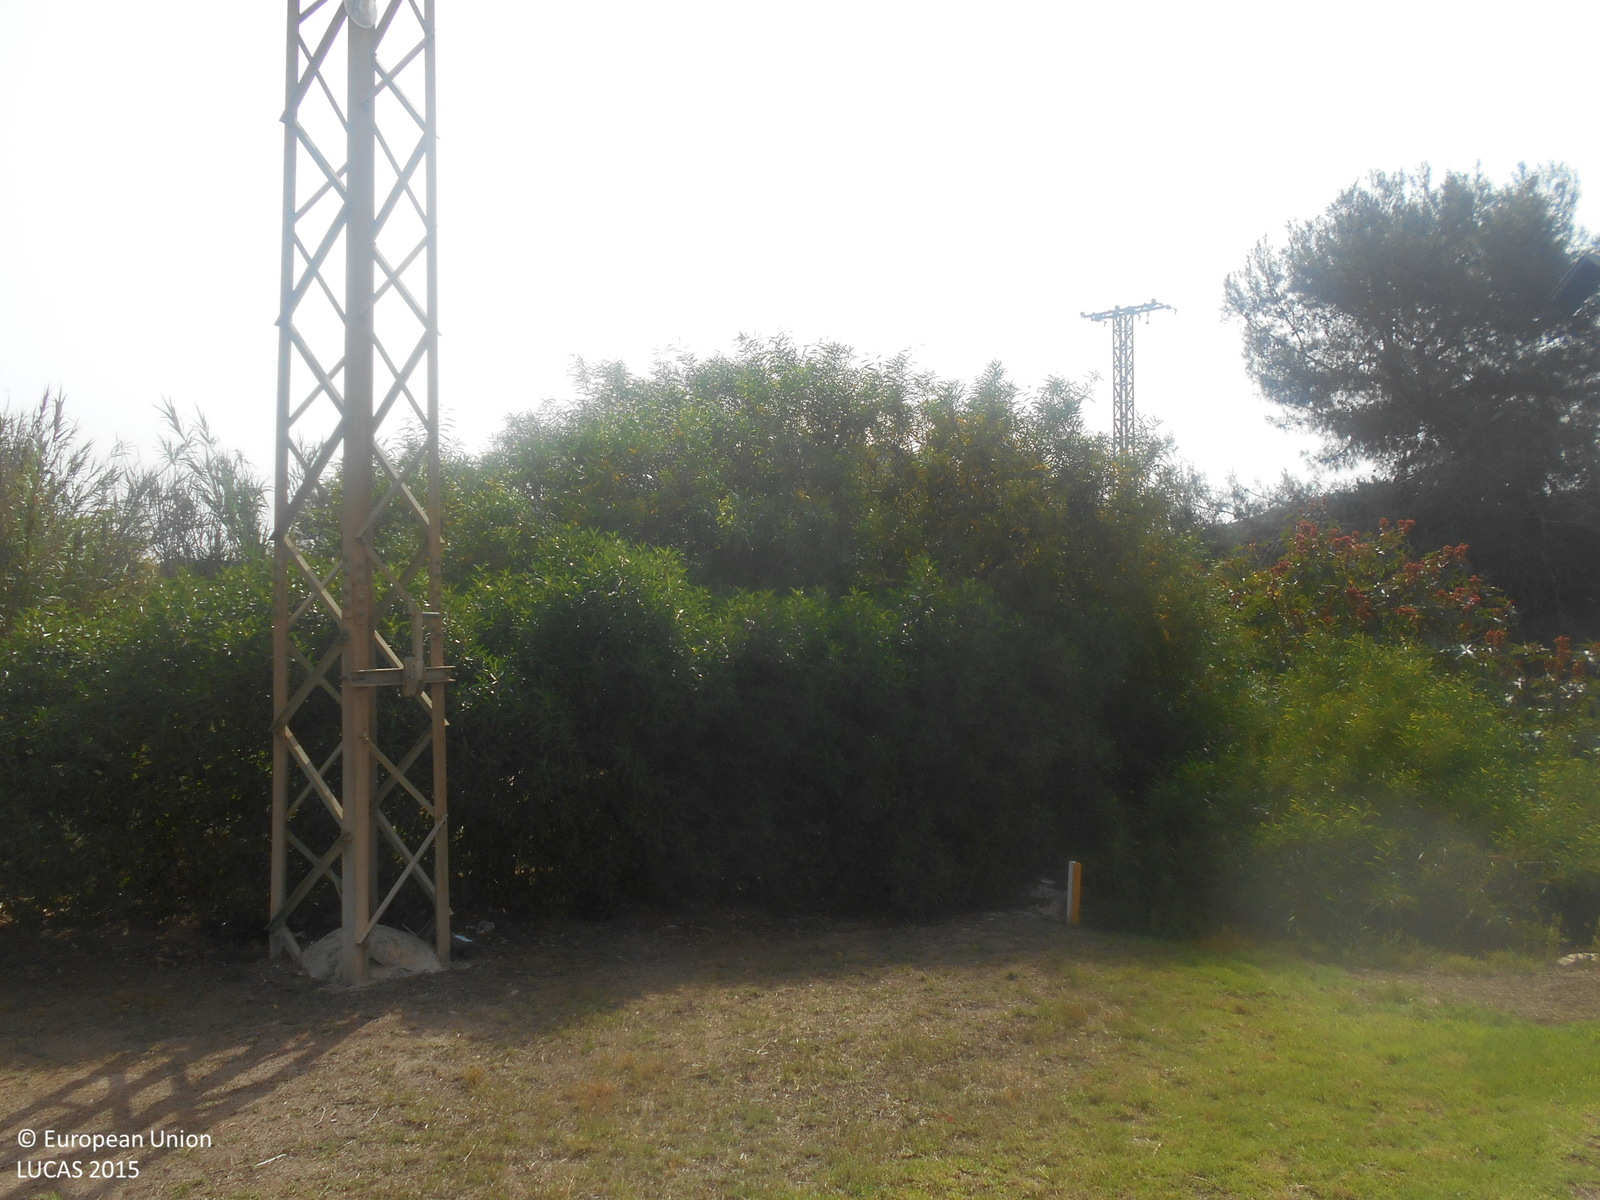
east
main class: Grassland
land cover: Grassland with sparse tree/shrub cover
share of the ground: 50 - 75 %
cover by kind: herbaceous plants 50 %, unconsolidated bare surface 45 %, broadleaved forest trees 5 %
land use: Sport
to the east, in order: Paved roads, cycling and walking lanes; Grassland with sparse tree/shrub cover; Managed hedges; Electric lines; Broadleaved woodland; Groves; Electric lines; Managed hedges; Shrubland without tree cover; Other bare soil; Tracks; Other bare soil; Tracks; Spontaneously vegetated surfaces
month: May
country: ES
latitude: 37.6064
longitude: -0.7957
